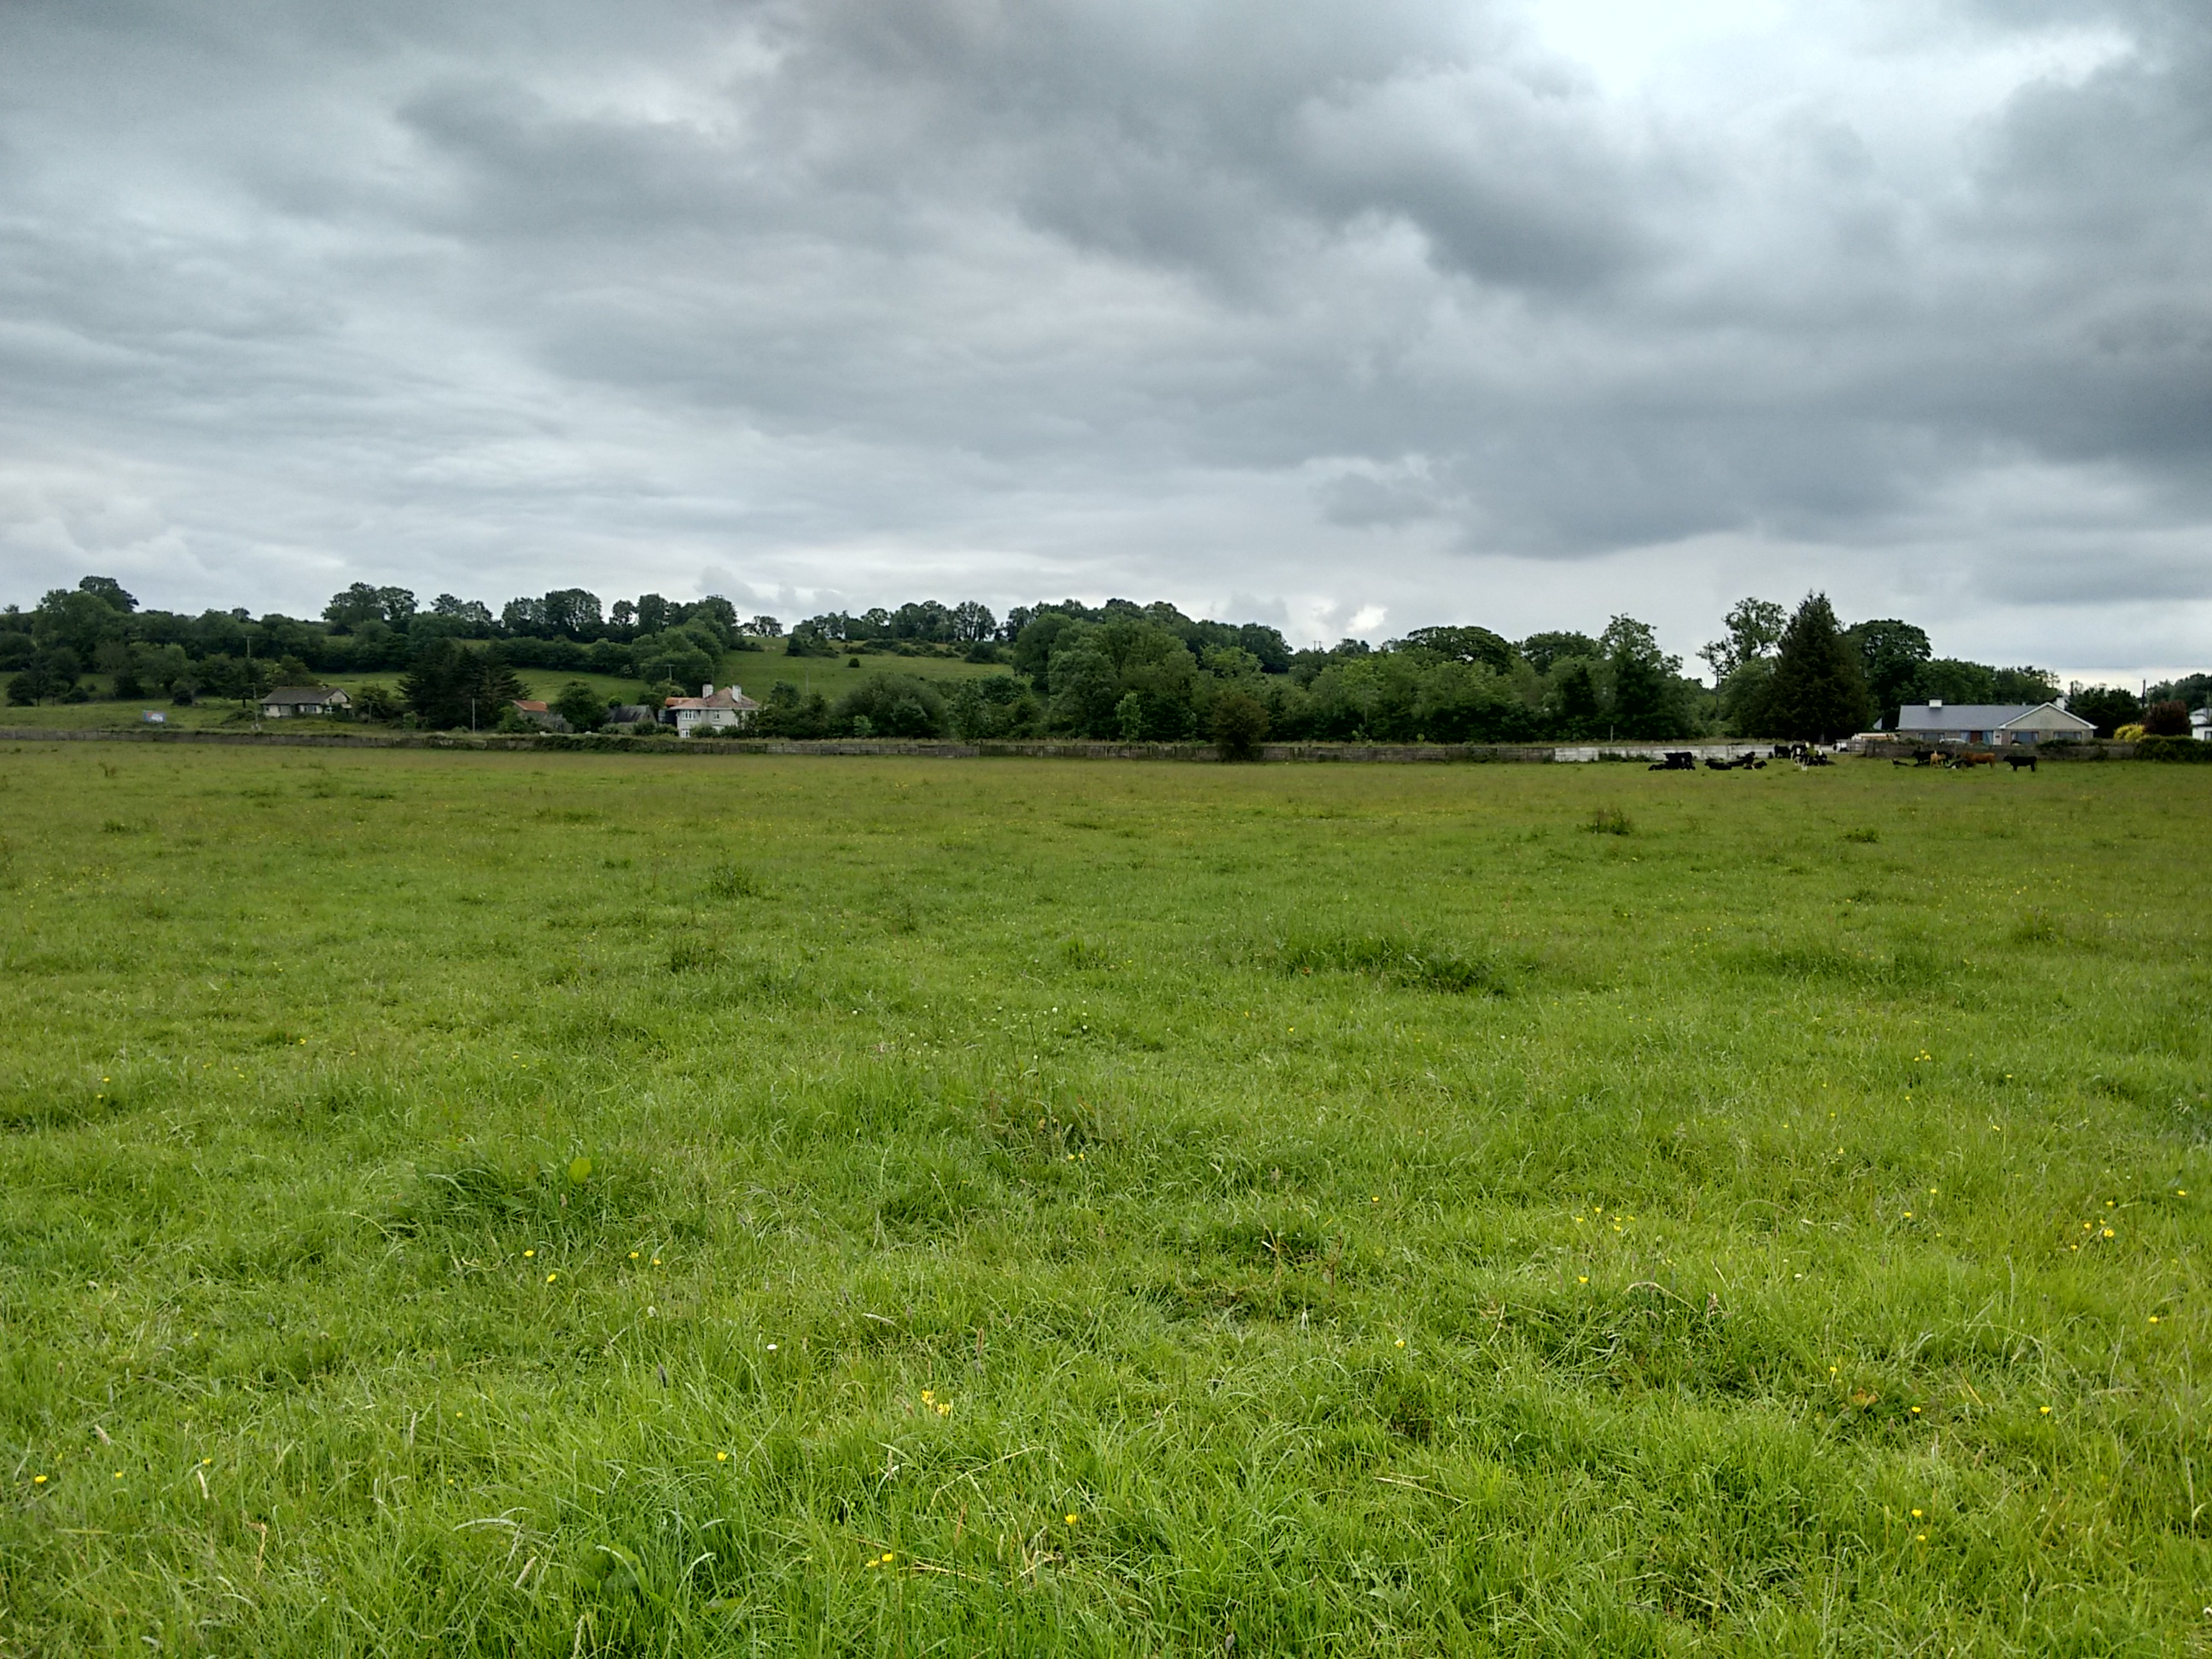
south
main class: Grassland
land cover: Grassland without tree/shrub cover
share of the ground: > 75 %
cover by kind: herbaceous plants 95 %, shrubs 5 %
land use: Agriculture (excluding fallow land and kitchen gardens)
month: June
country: IE
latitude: 53.4025
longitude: -7.8740
